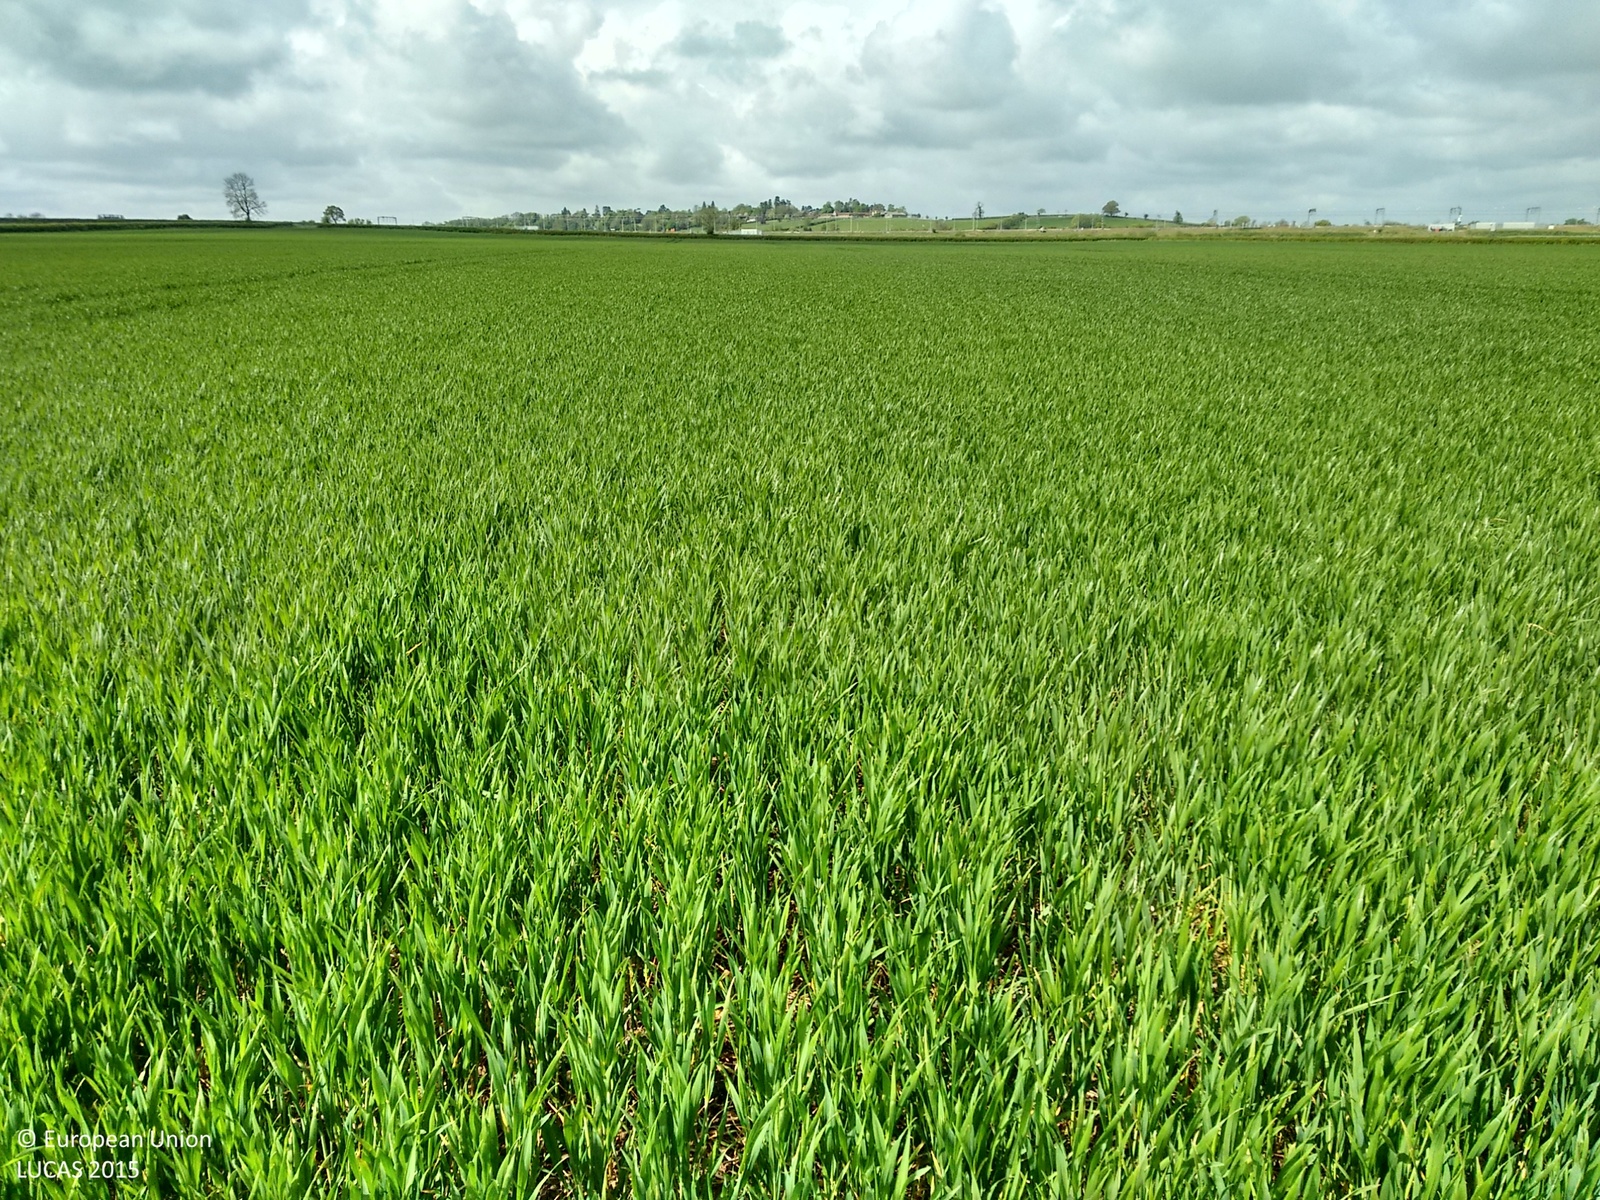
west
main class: Cropland
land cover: Common wheat
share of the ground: > 75 %
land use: Agriculture (excluding fallow land and kitchen gardens)
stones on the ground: 10 - 25 %
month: May
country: GB
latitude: 51.8780
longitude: -0.6589
